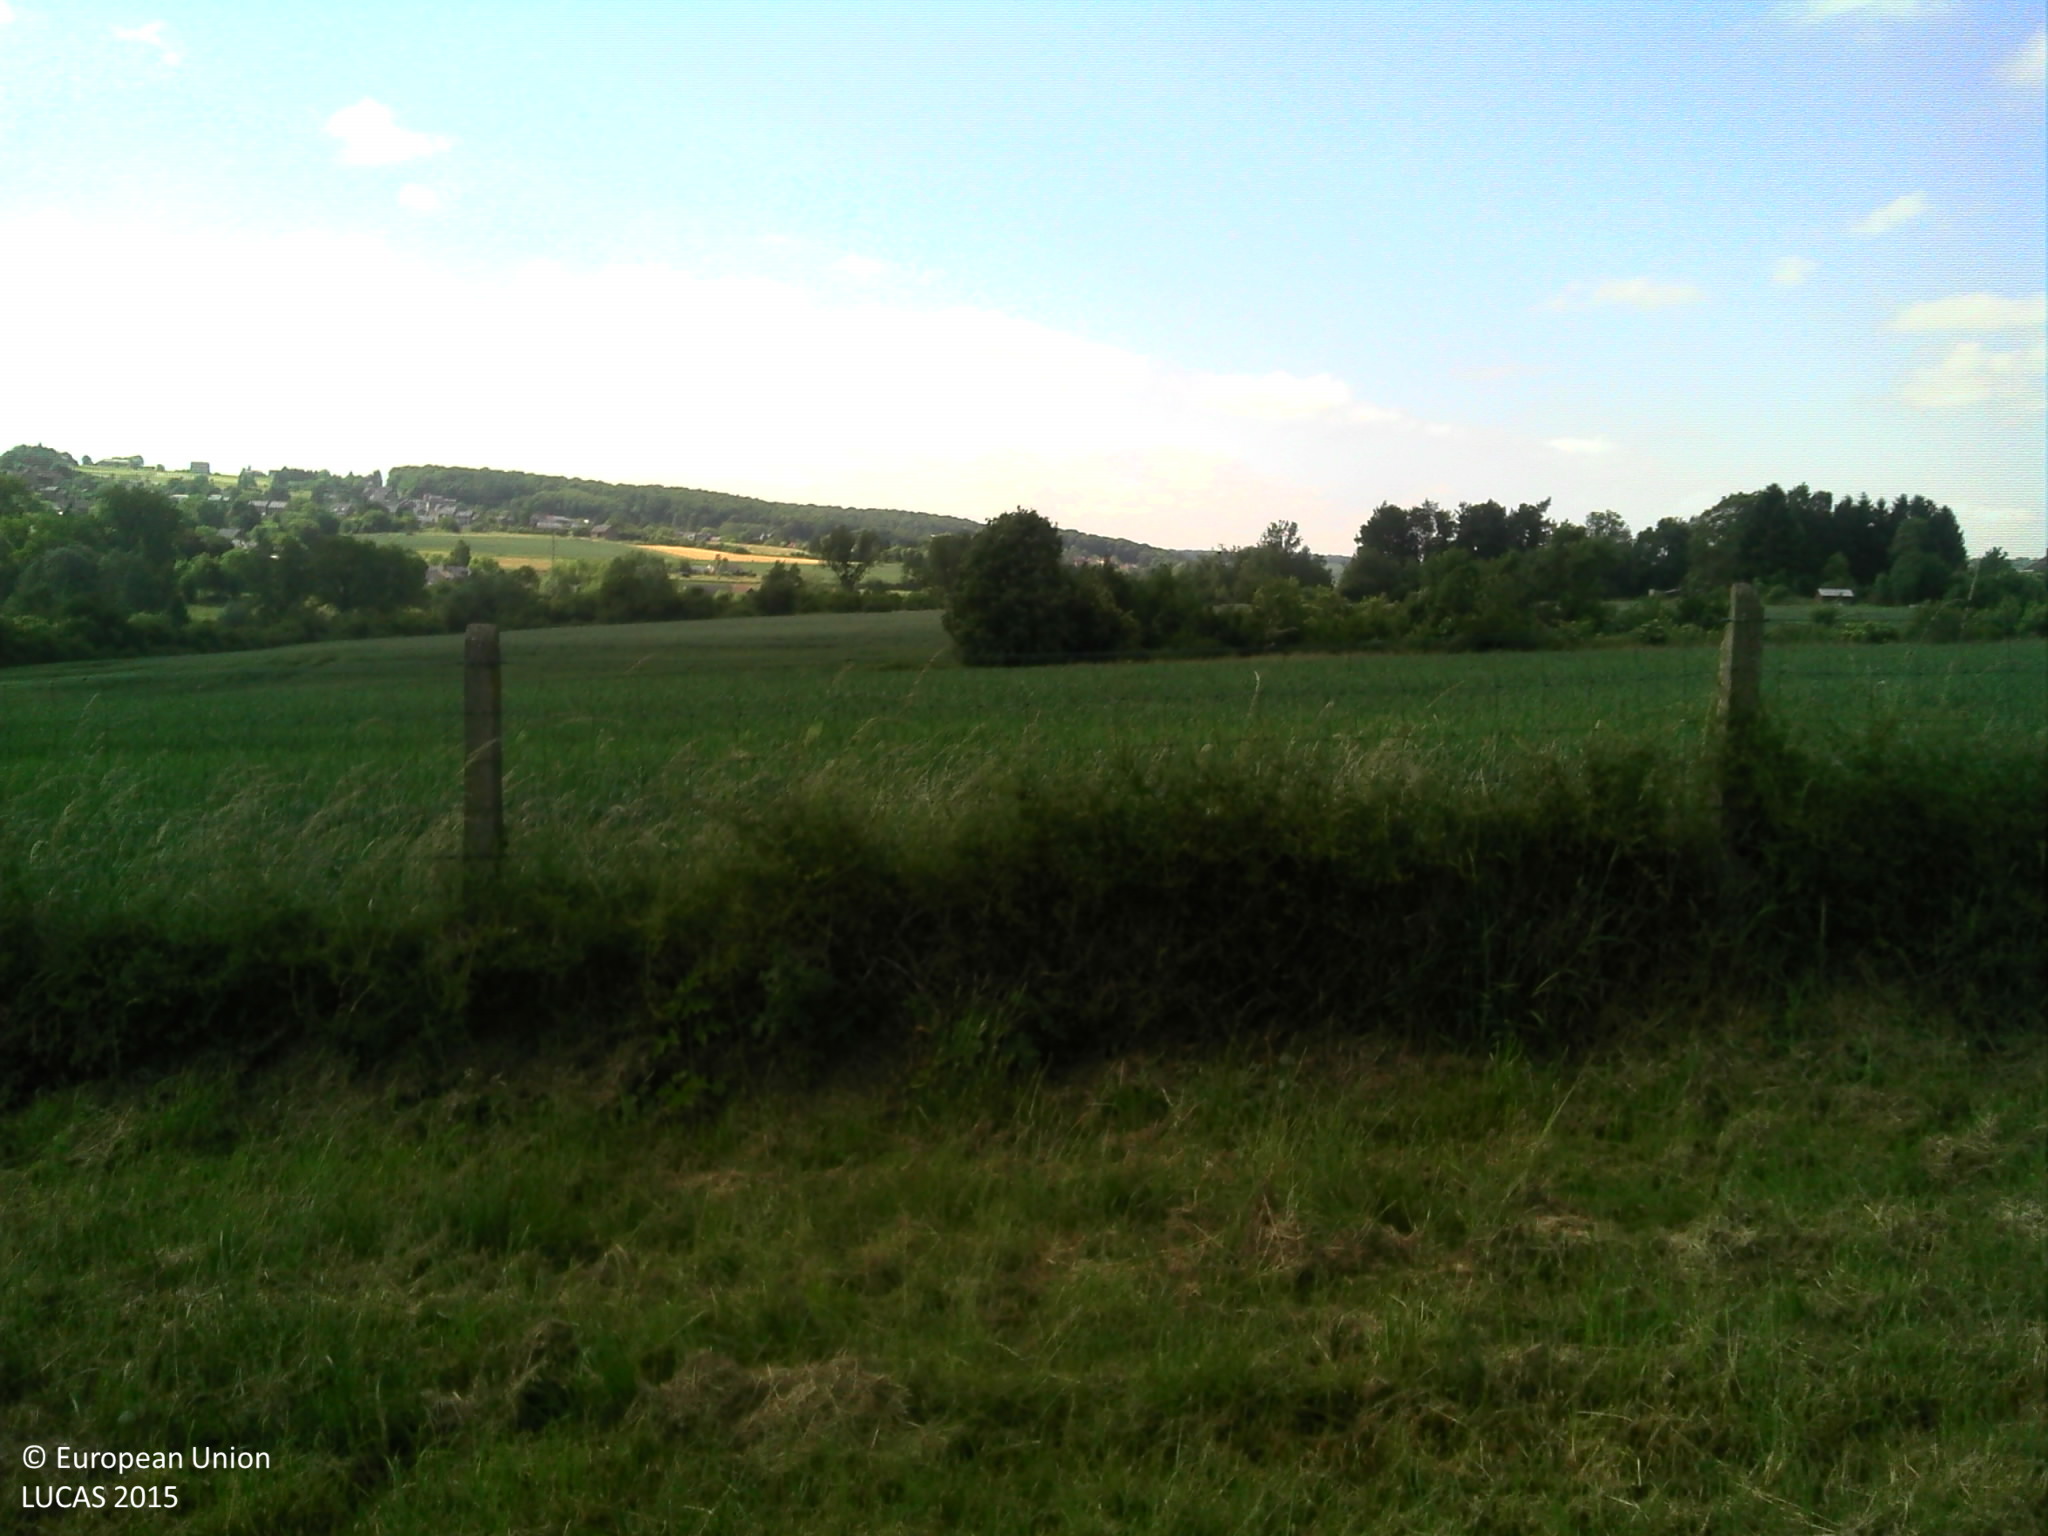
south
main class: Grassland
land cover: Grassland without tree/shrub cover
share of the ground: > 75 %
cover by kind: herbaceous plants 100 %
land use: Residential
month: June
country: BE
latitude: 50.4363
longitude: 4.6320
